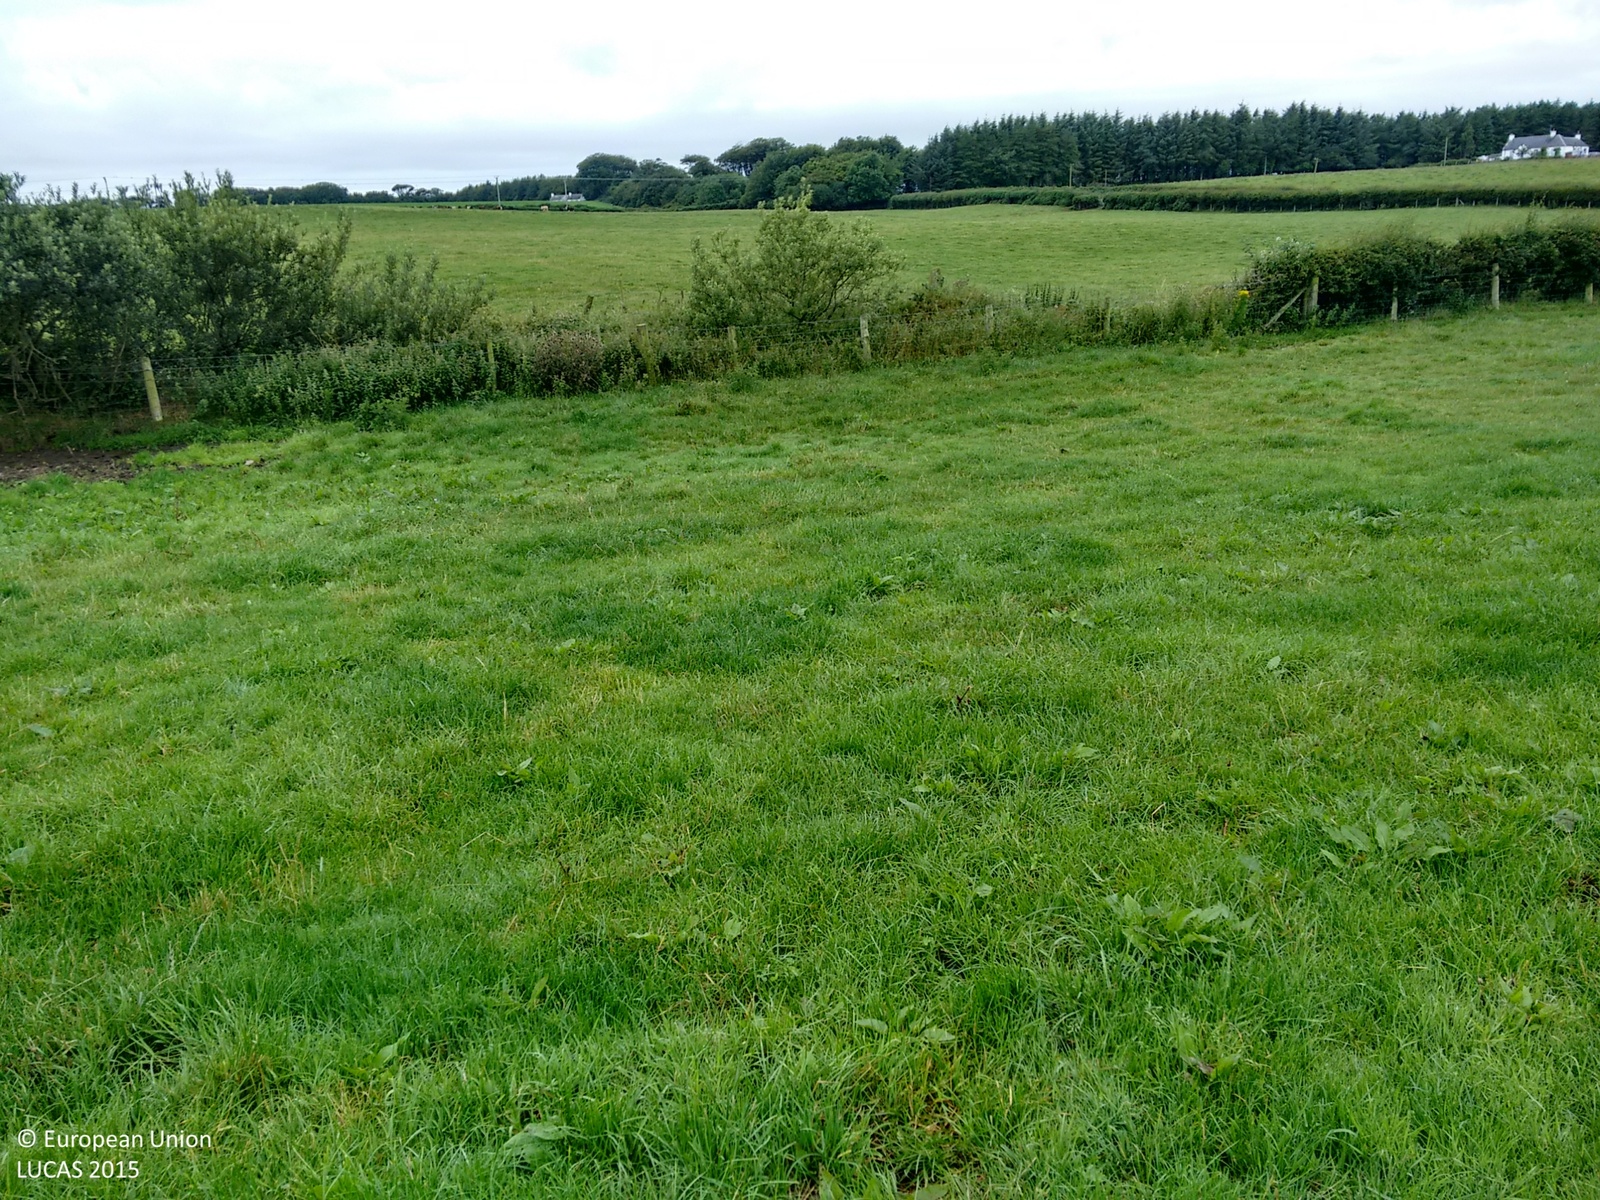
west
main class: Grassland
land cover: Grassland without tree/shrub cover
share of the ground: > 75 %
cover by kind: herbaceous plants 100 %
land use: Agriculture (excluding fallow land and kitchen gardens)
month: August
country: GB
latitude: 54.8813
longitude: -4.9674
